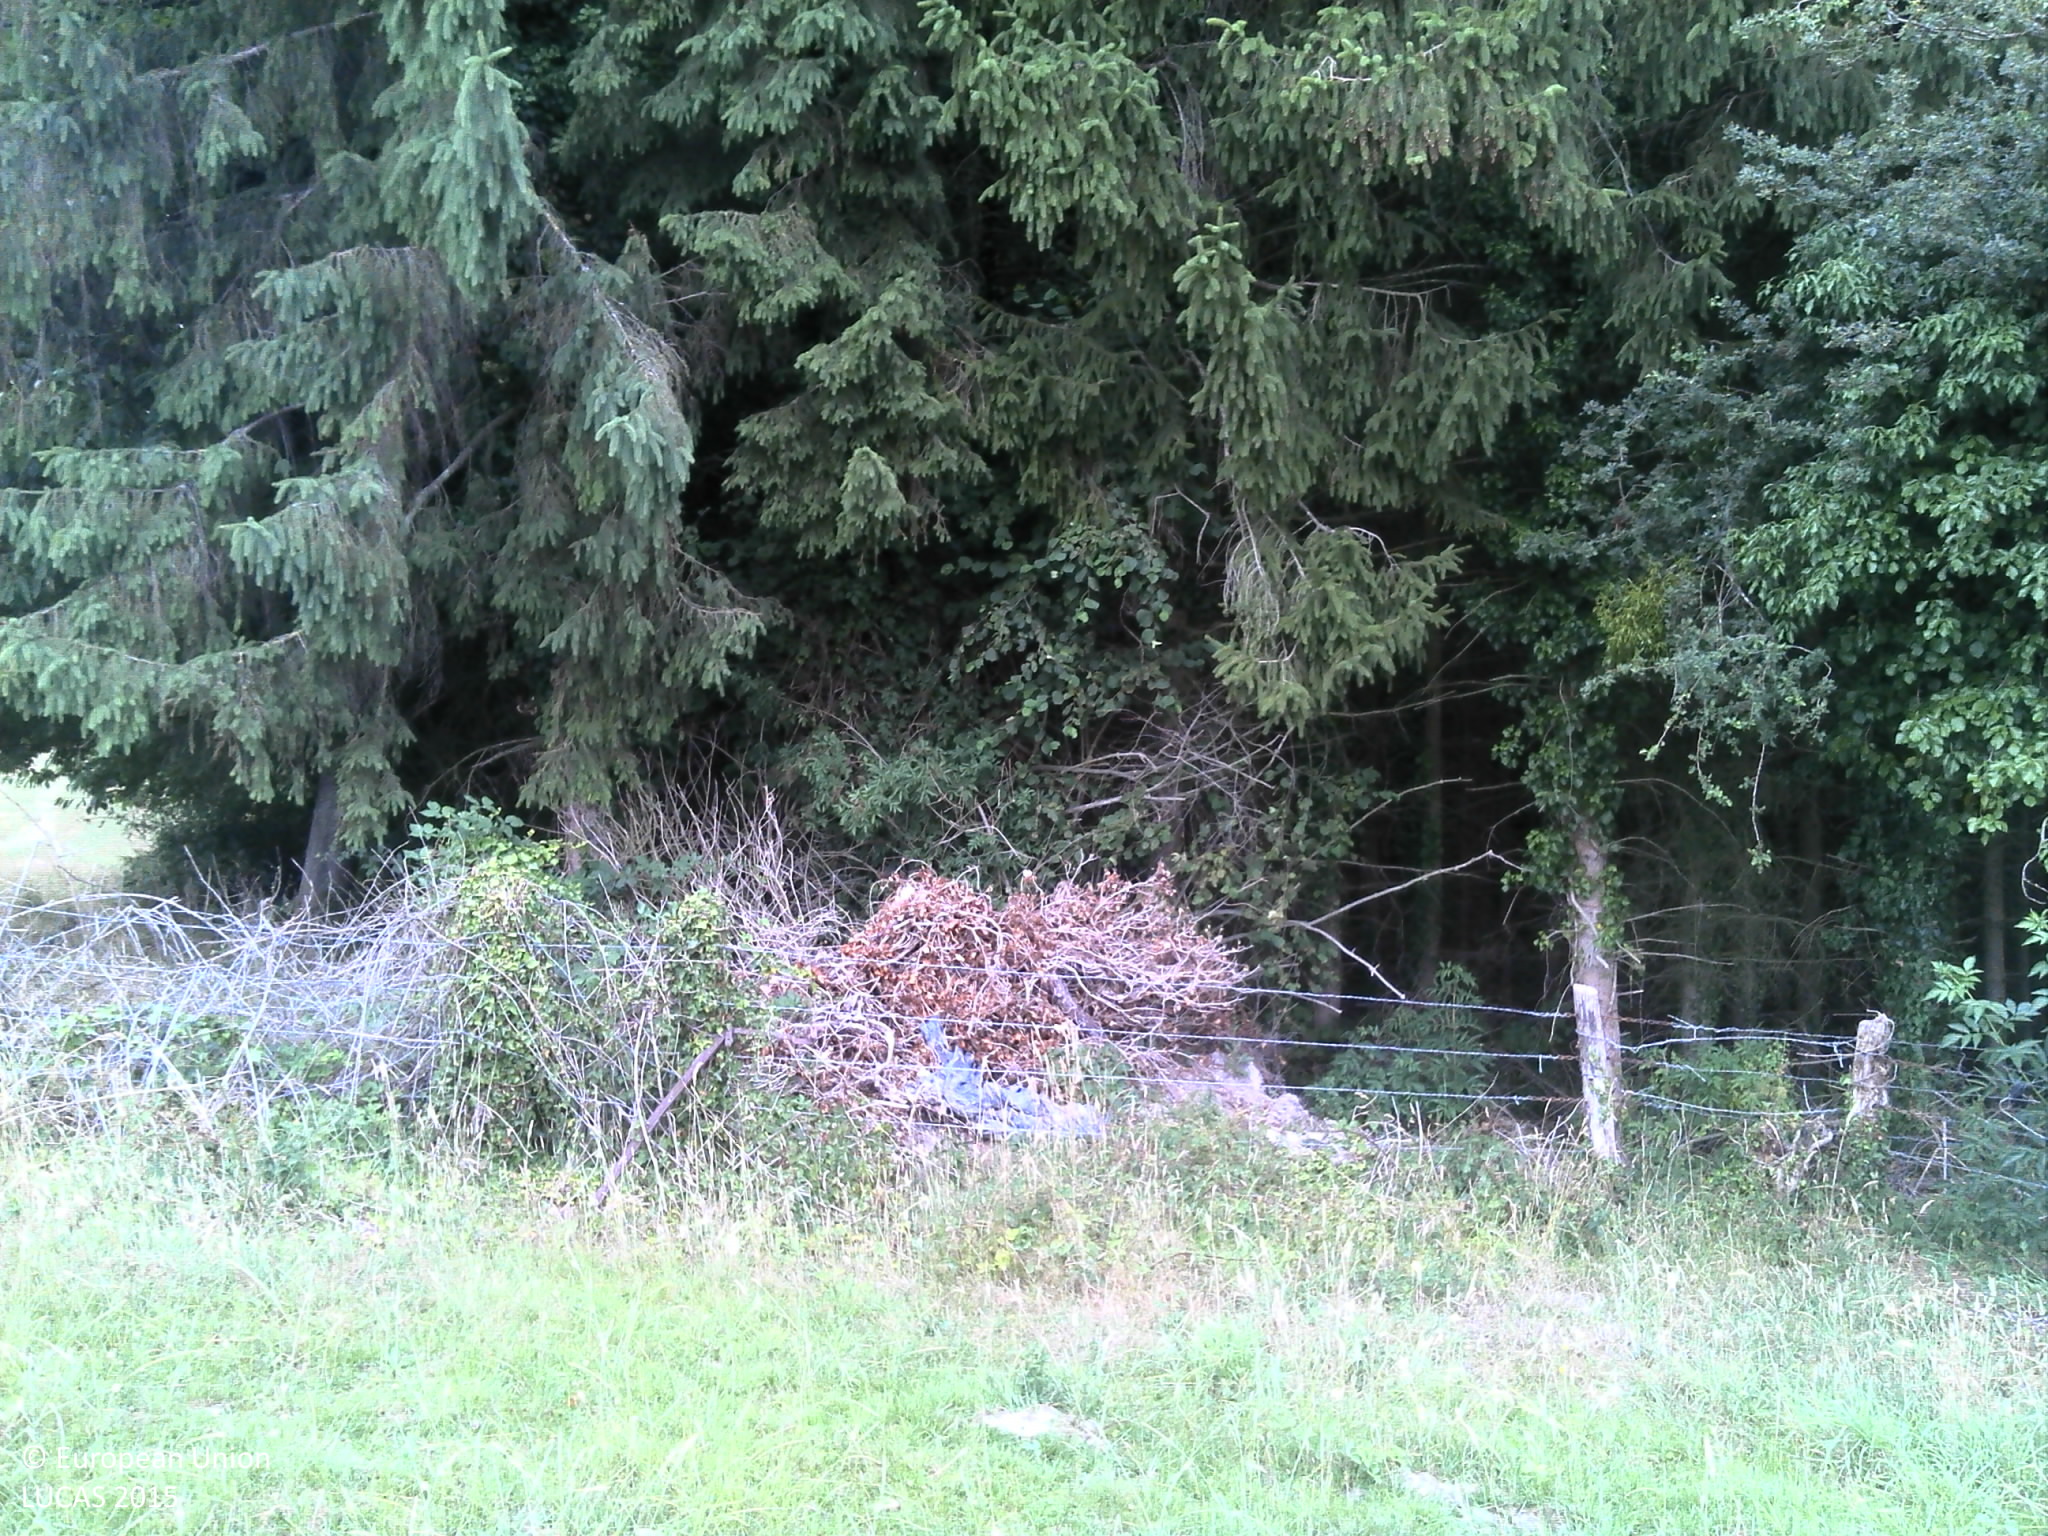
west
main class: Grassland
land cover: Grassland without tree/shrub cover
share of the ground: > 75 %
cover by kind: herbaceous plants 100 %
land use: Agriculture (excluding fallow land and kitchen gardens)
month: July
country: FR
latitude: 49.3964
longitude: 4.7473
